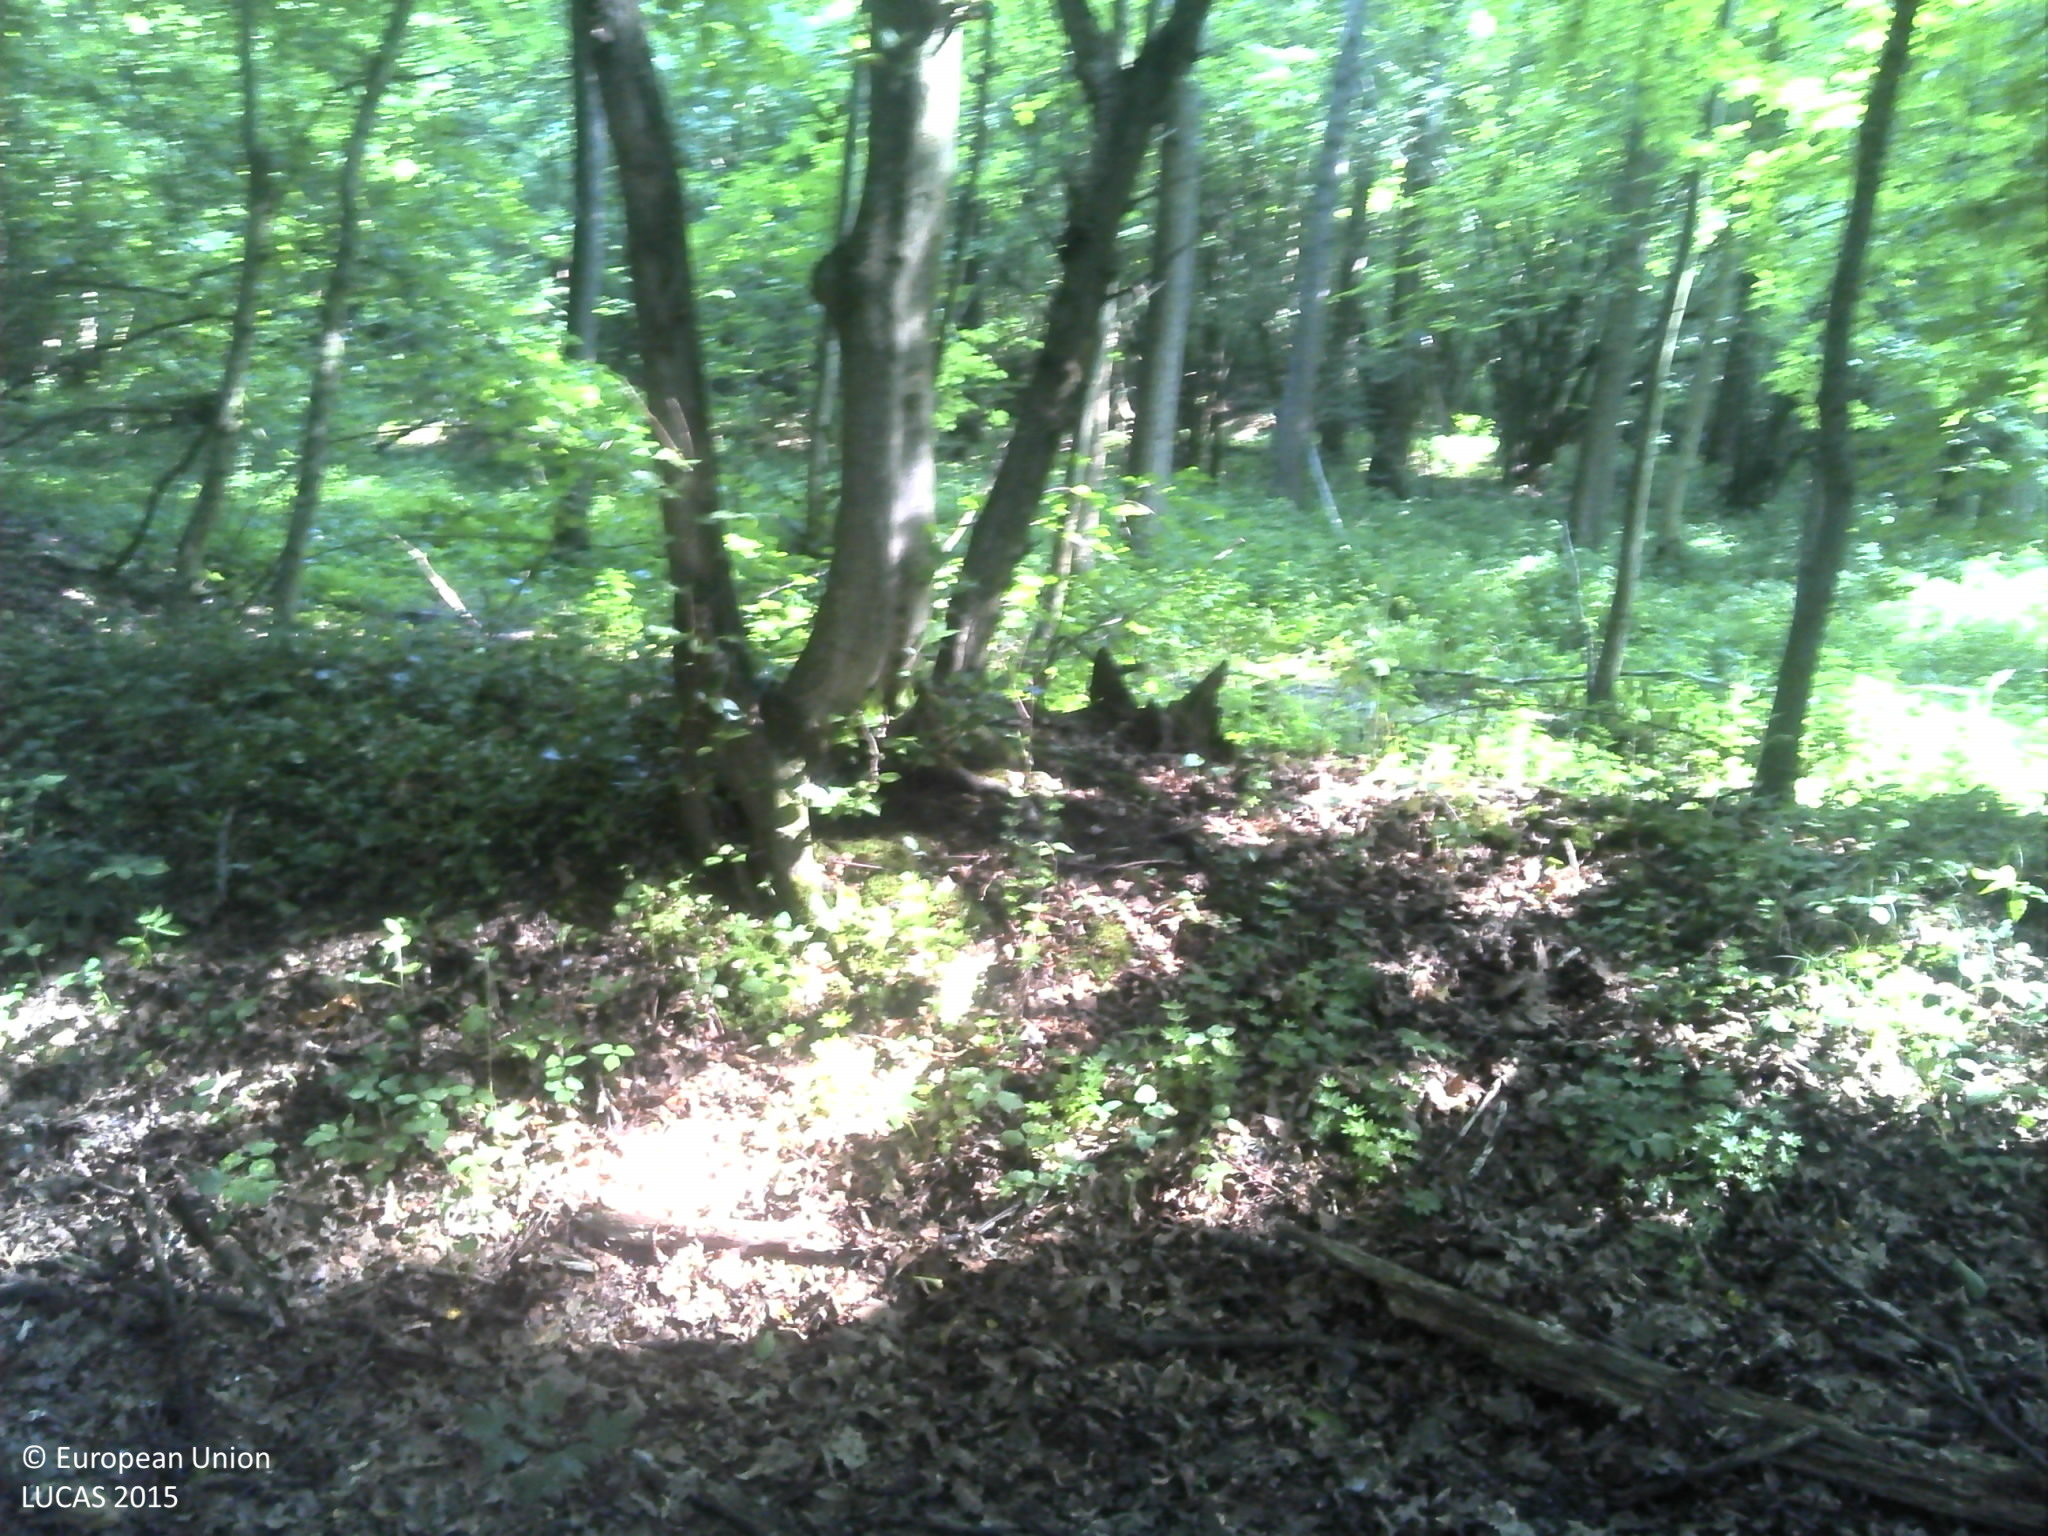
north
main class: Woodland
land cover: Broadleaved woodland
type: acidophilous oak and oak-birch forest
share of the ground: > 75 %
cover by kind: broadleaved forest trees 90 %, shrubs 5 %, herbaceous plants 5 %
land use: Forestry
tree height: > 5 m
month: June
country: HR
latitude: 45.5157
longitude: 17.9017
